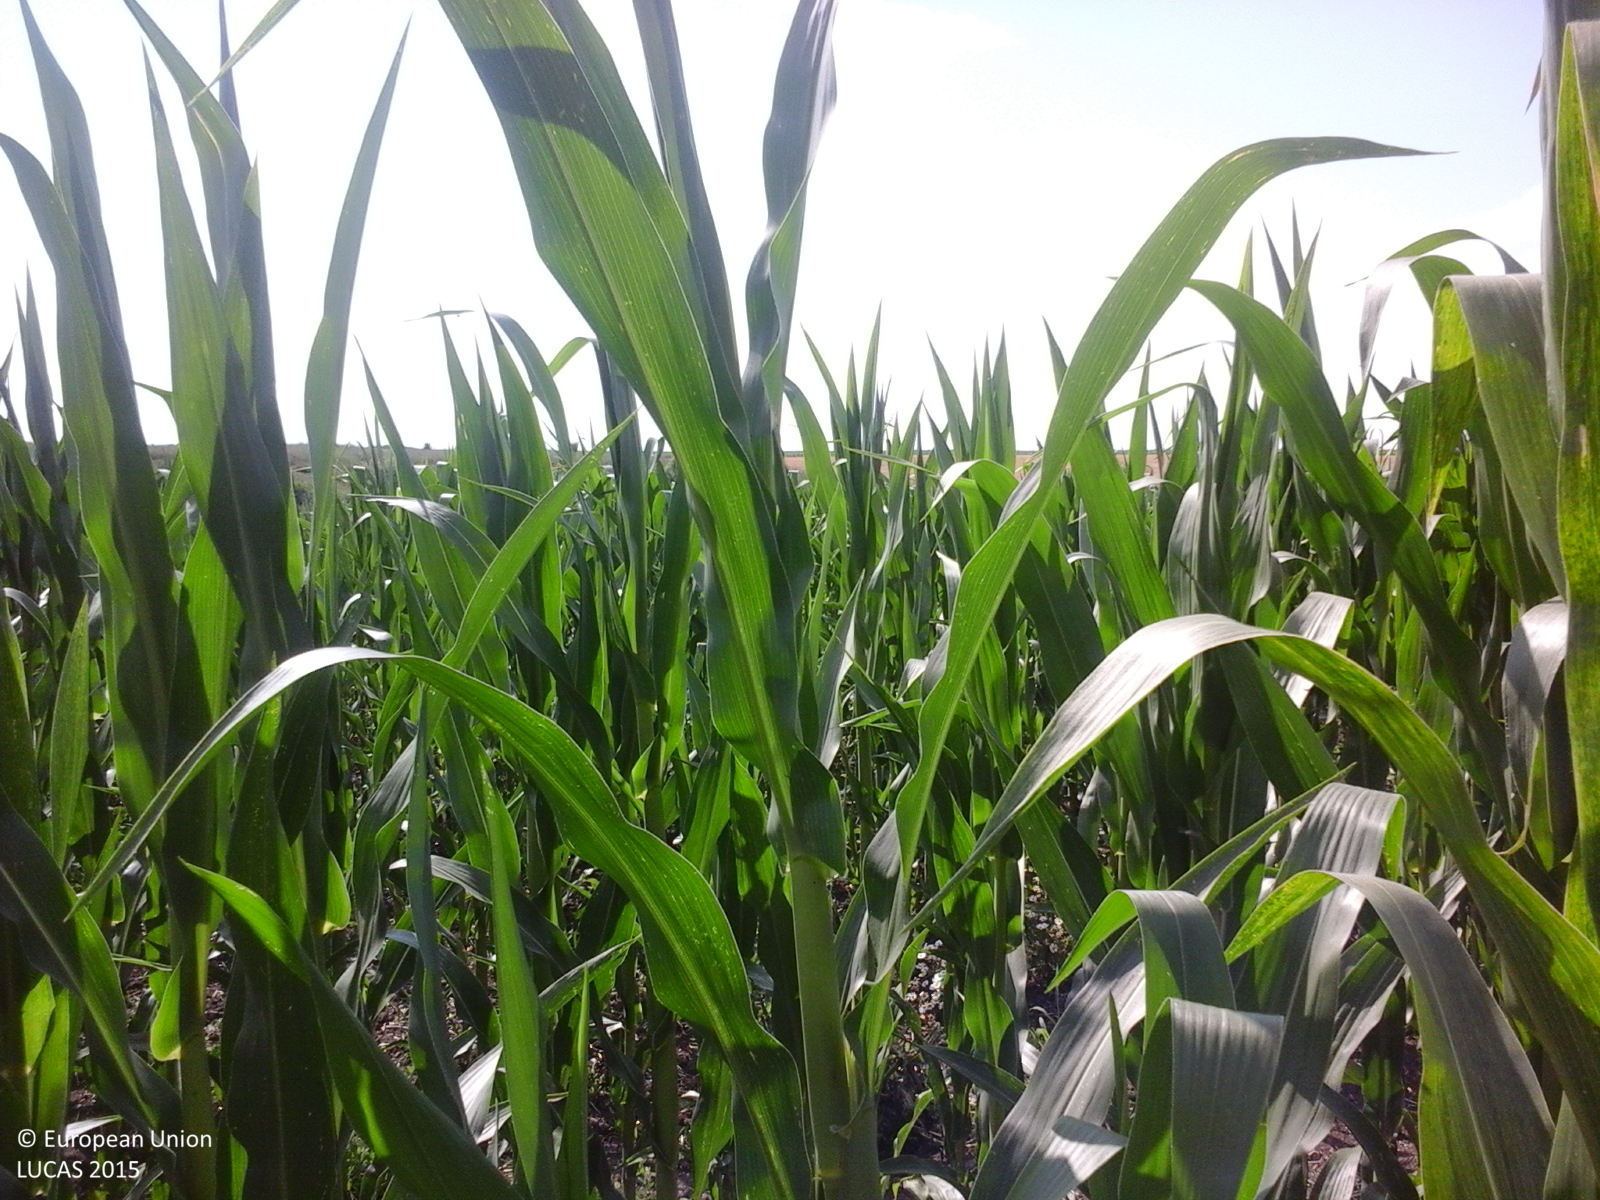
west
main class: Cropland
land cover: Maize
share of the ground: > 75 %
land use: Agriculture (excluding fallow land and kitchen gardens)
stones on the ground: < 10 %
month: July
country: RO
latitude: 44.3369
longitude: 25.3506
